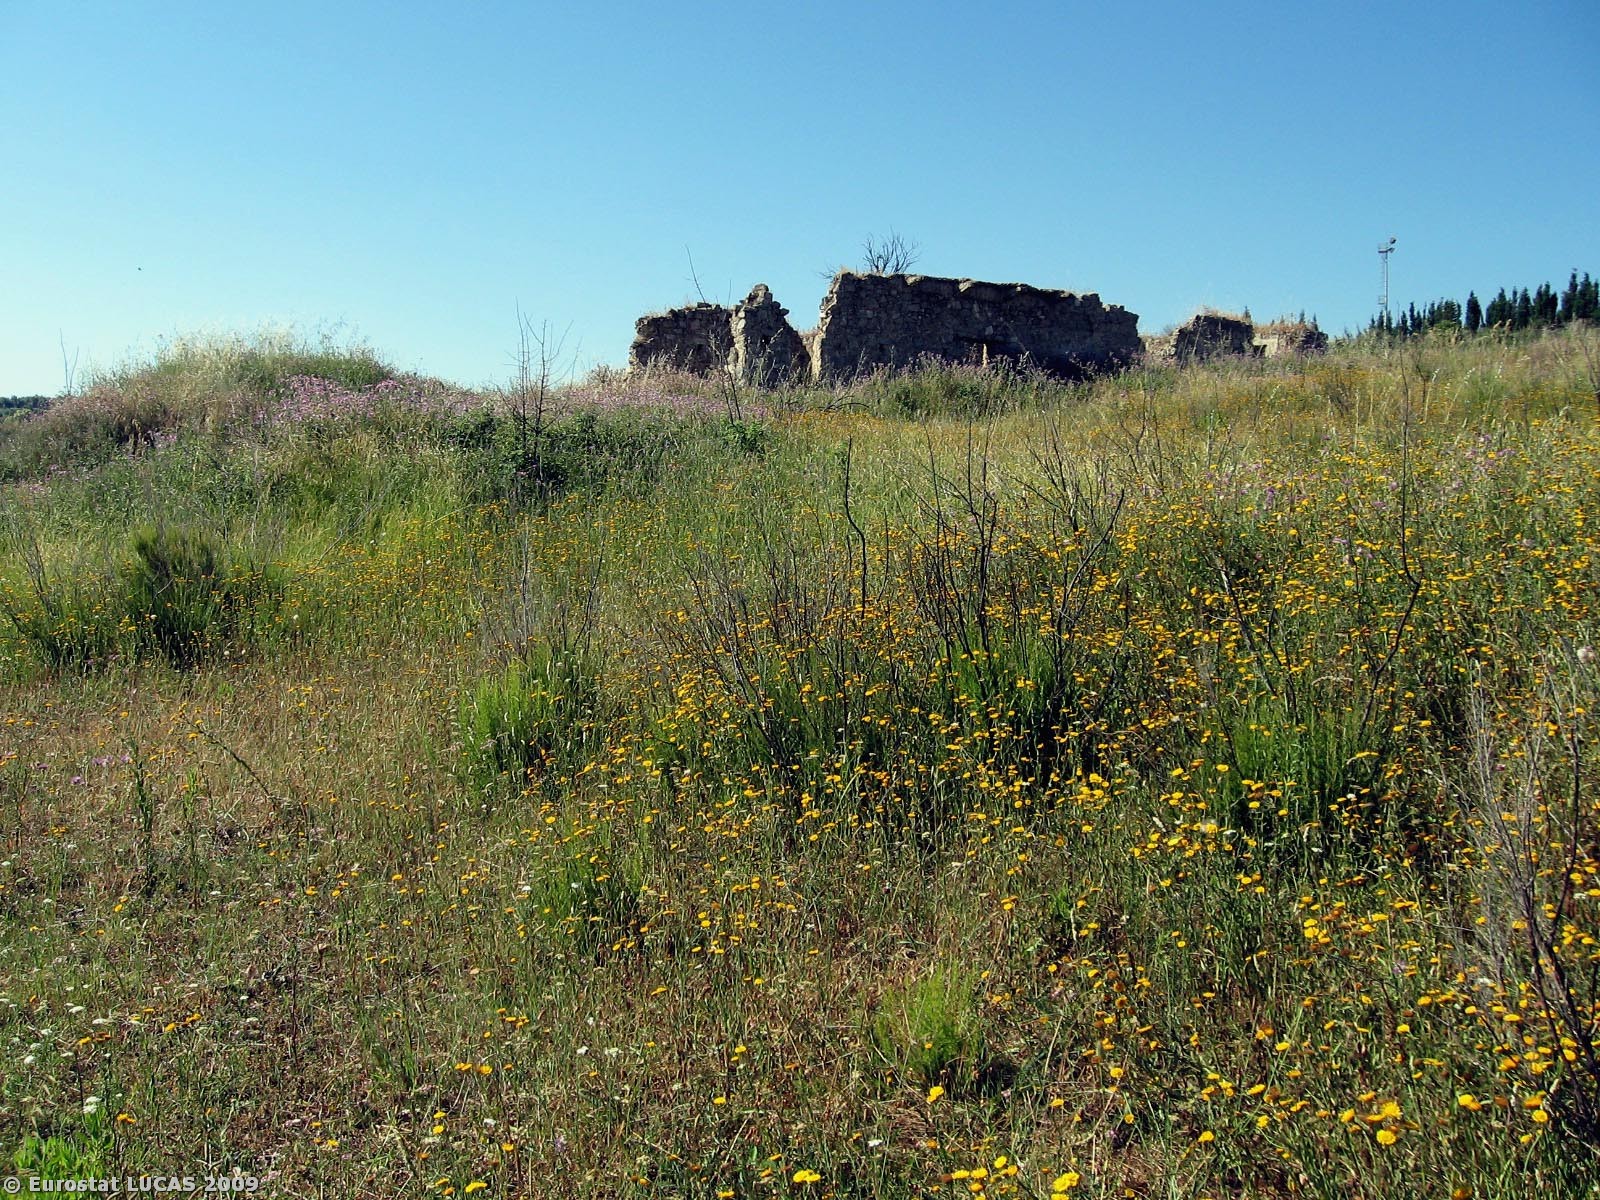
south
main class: Grassland
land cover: Grassland without tree/shrub cover
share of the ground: 50 - 75 %
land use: Fallow land
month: June
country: IT
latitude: 38.6867
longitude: 15.9789
